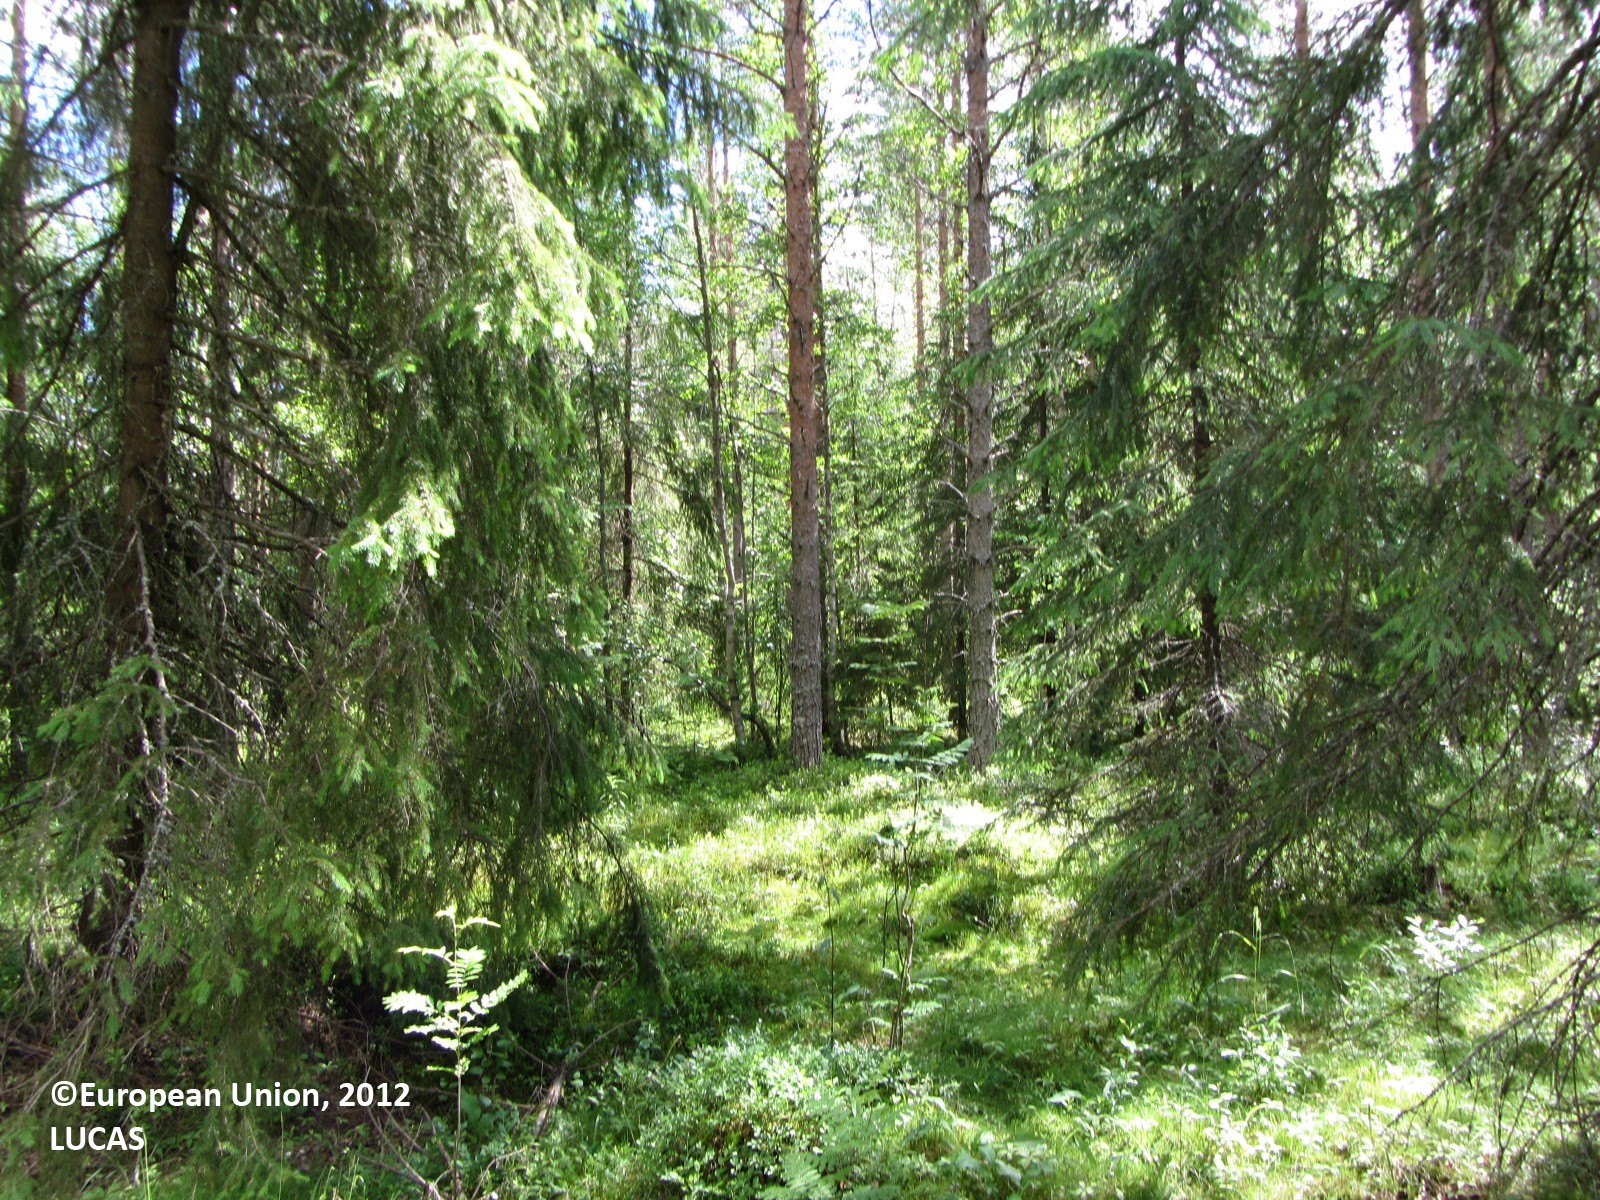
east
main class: Woodland
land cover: Other mixed woodland
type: boreal forest
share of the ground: > 75 %
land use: Forestry
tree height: > 5 m
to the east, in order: Other mixed woodland; Ditches and canals; Other mixed woodland; Tracks; Other mixed woodland; Tracks; Pine dominated mixed woodland; Broadleaved woodland; Pine dominated mixed woodland; Ditches and canals; Managed hedges; Paved roads, cycling and walking lanes; Grass margins; Abandoned hedges; Ditches and canals; Broadleaved woodland; Pine dominated mixed woodland; Shrubland with sparse tree cover; Pine dominated mixed woodland; Shrubland with sparse tree cover
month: July
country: FI
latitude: 62.8335
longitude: 25.5200
